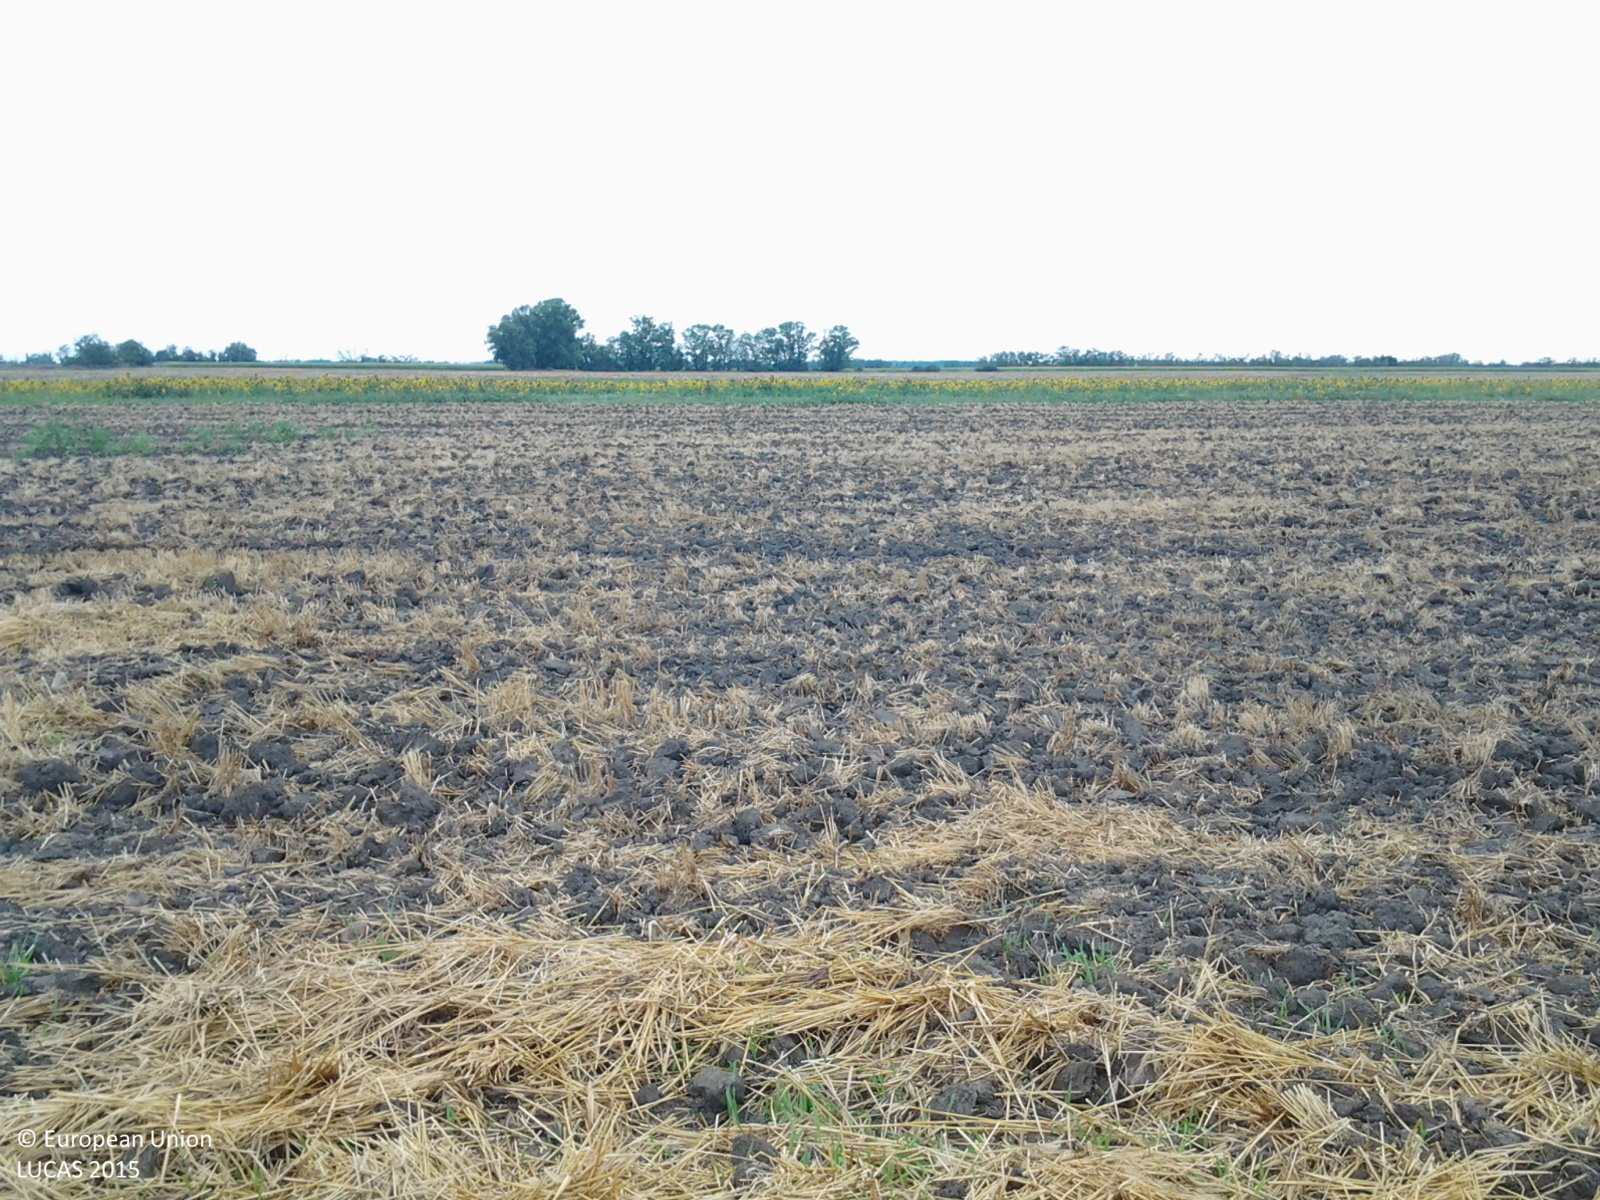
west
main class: Cropland
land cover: Barley
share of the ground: < 10 %
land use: Agriculture (excluding fallow land and kitchen gardens)
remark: Harvested field
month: July
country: HU
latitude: 47.1719
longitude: 20.5452
